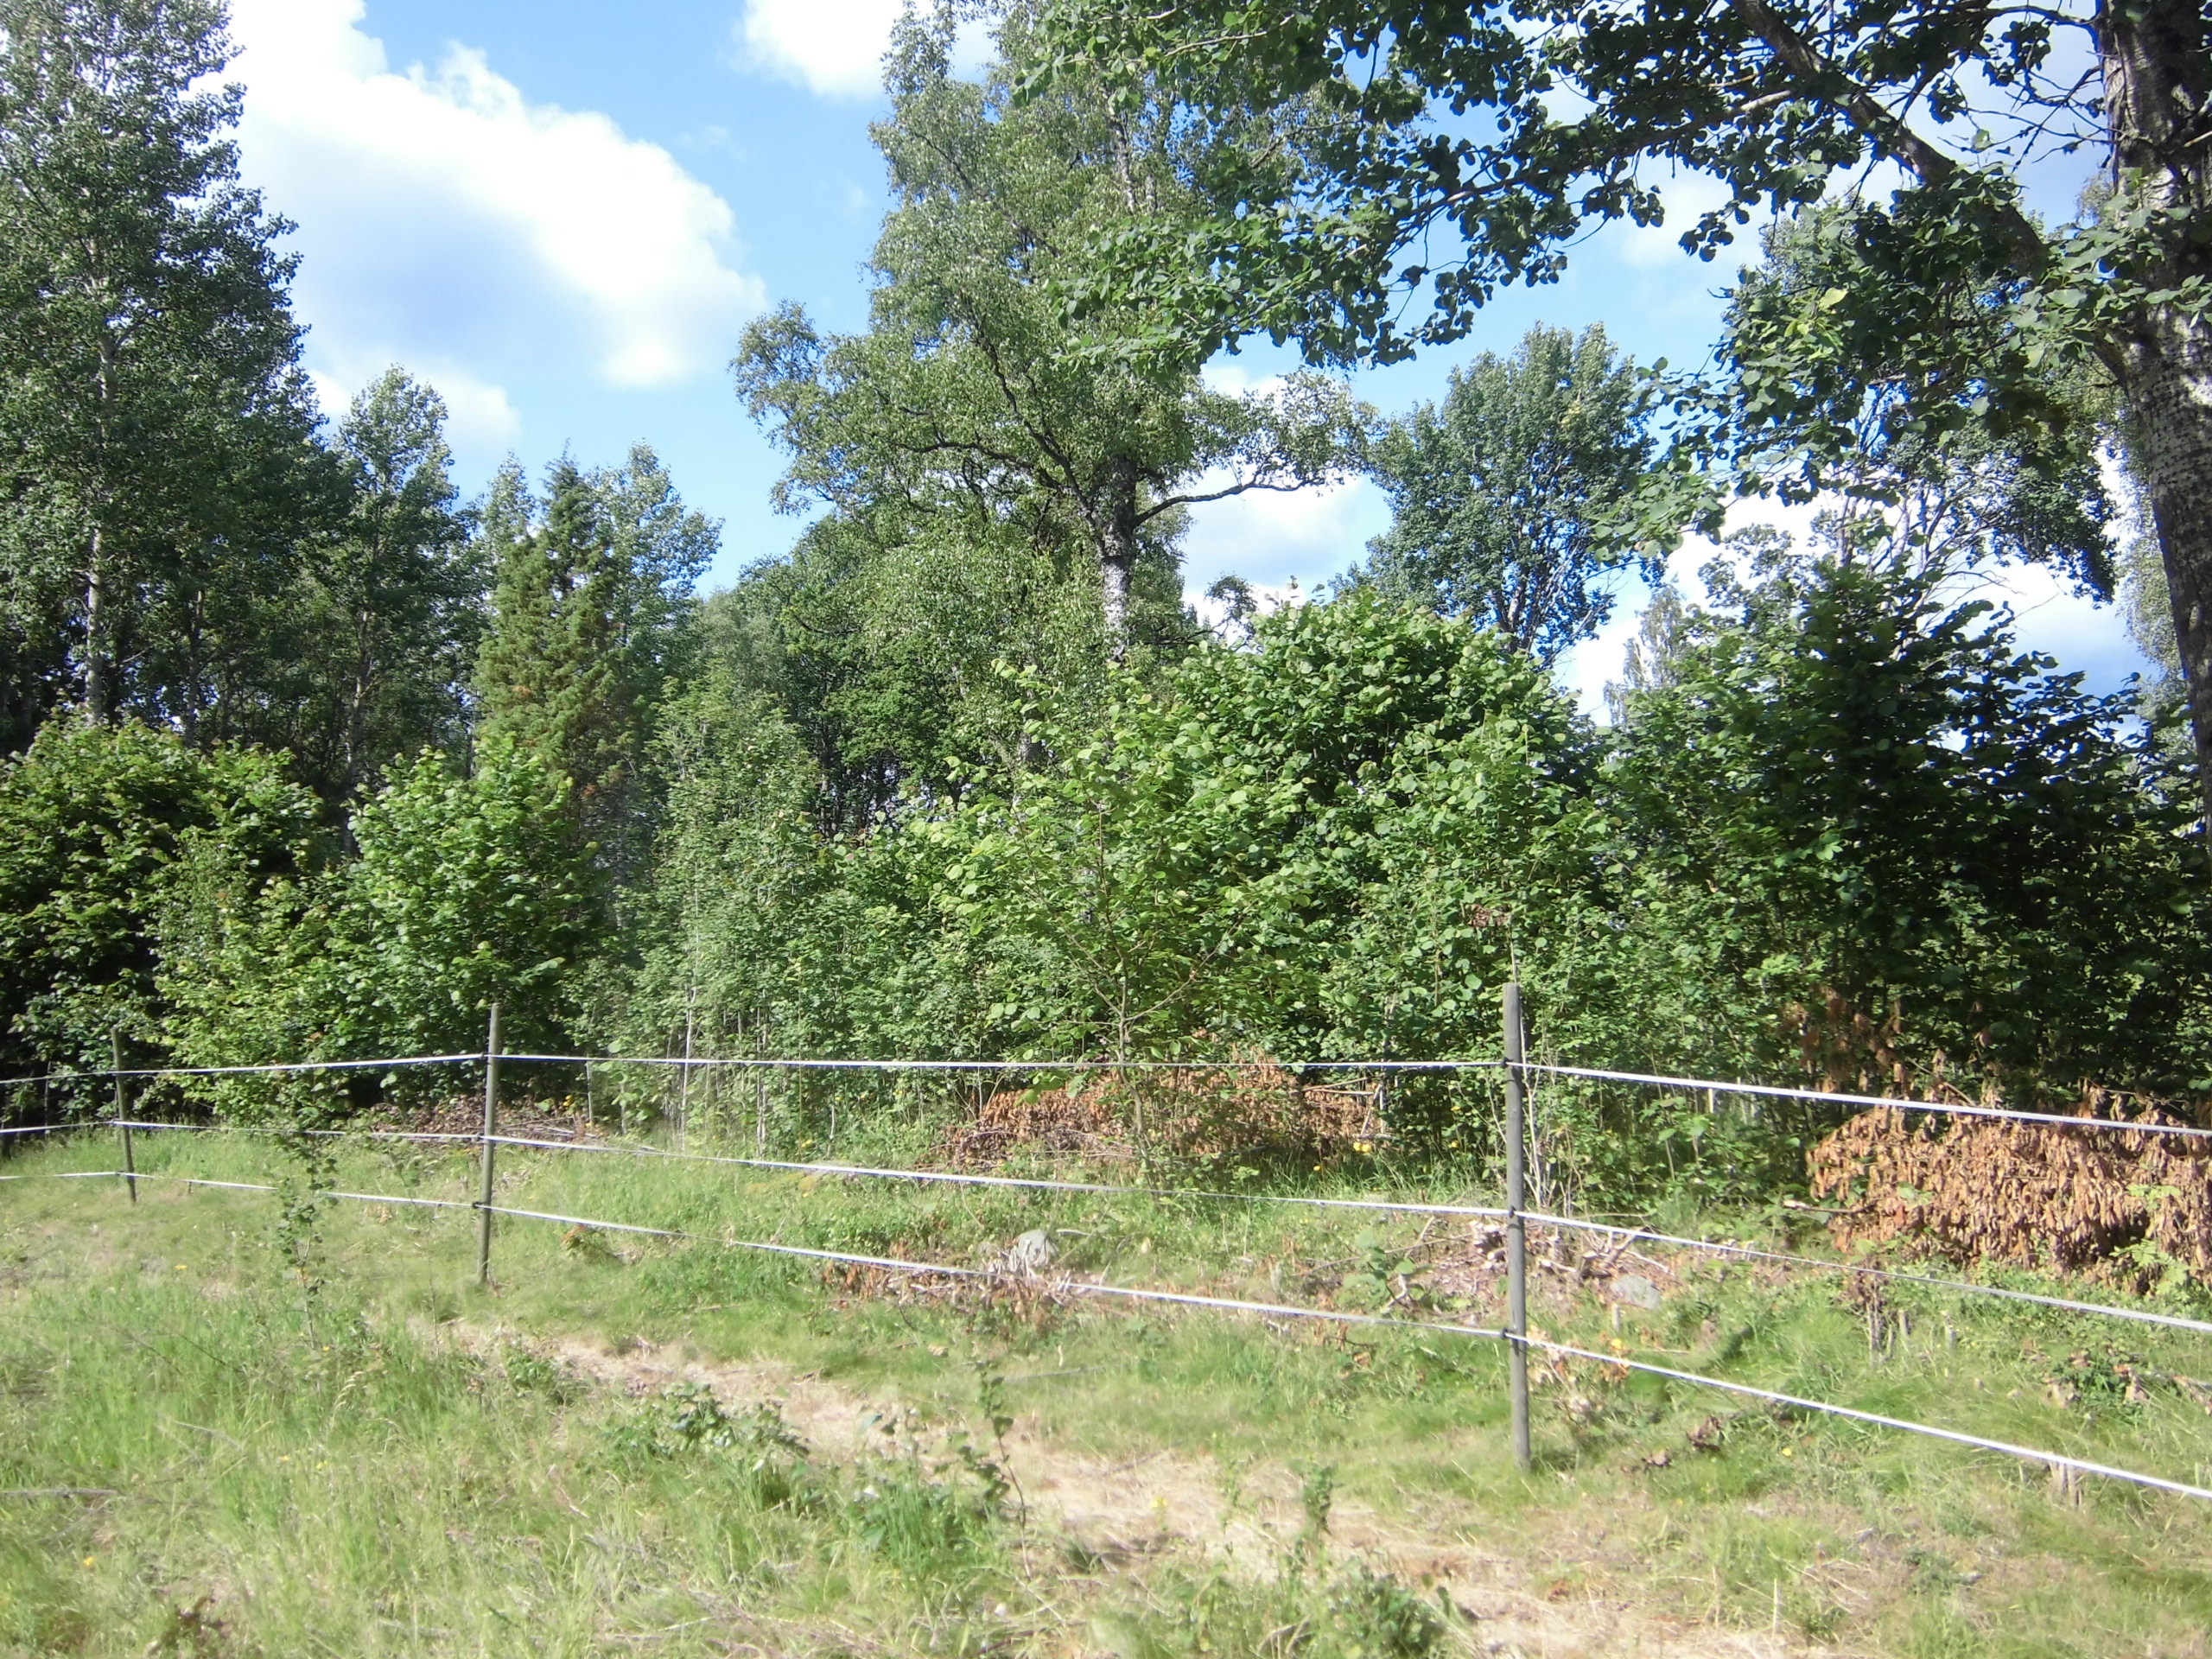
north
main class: Grassland
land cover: Grassland with sparse tree/shrub cover
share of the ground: > 75 %
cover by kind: herbaceous plants 95 %, broadleaved forest trees 5 %
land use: Agriculture (excluding fallow land and kitchen gardens)
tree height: < 5 m
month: July
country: SE
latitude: 57.2119
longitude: 15.3451
